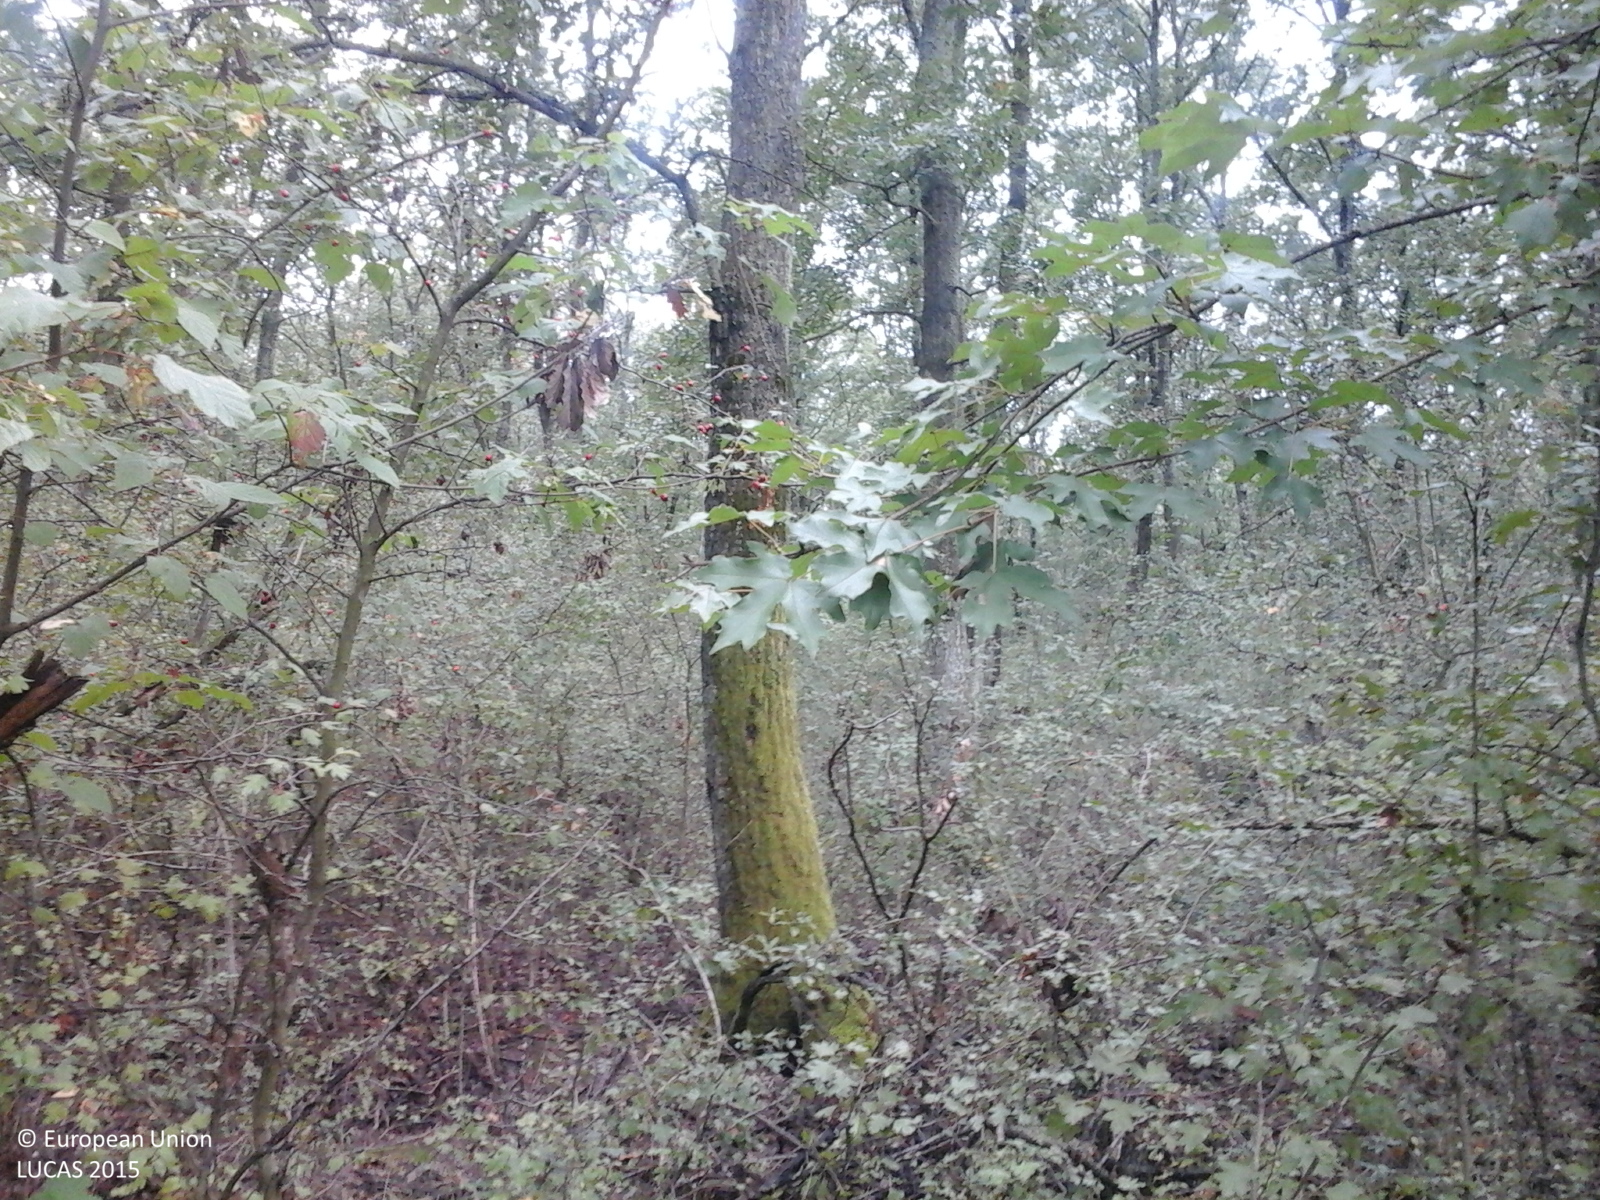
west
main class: Woodland
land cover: Broadleaved woodland
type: acidophilous oak and oak-birch forest
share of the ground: > 75 %
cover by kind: broadleaved forest trees 80 %, shrubs 10 %, herbaceous plants 10 %
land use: Forestry
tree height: > 5 m
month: September
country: RO
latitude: 46.8027
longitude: 21.8232
